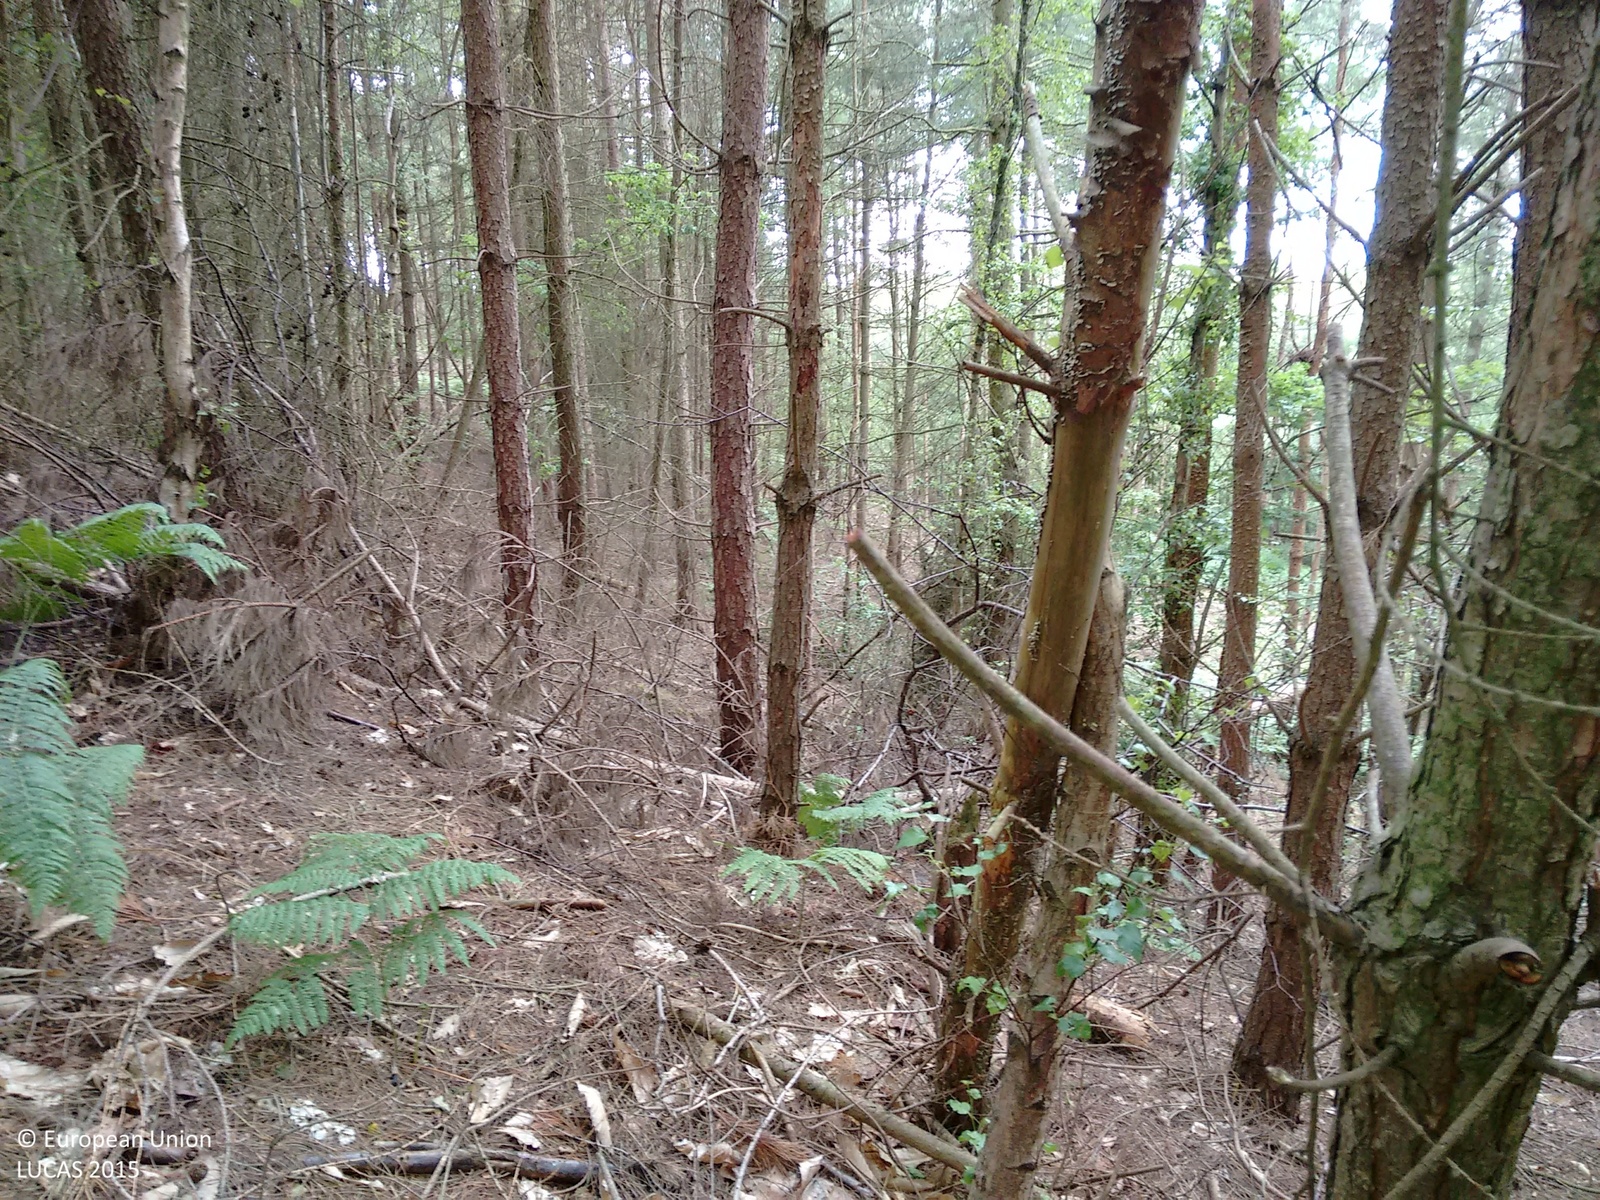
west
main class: Woodland
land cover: Pine dominated coniferous woodland
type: exotic forest
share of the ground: > 75 %
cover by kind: coniferous forest trees 90 %, broadleaved forest trees 10 %
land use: Forestry
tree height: > 5 m
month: June
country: GB
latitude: 52.0049
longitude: -0.6598
